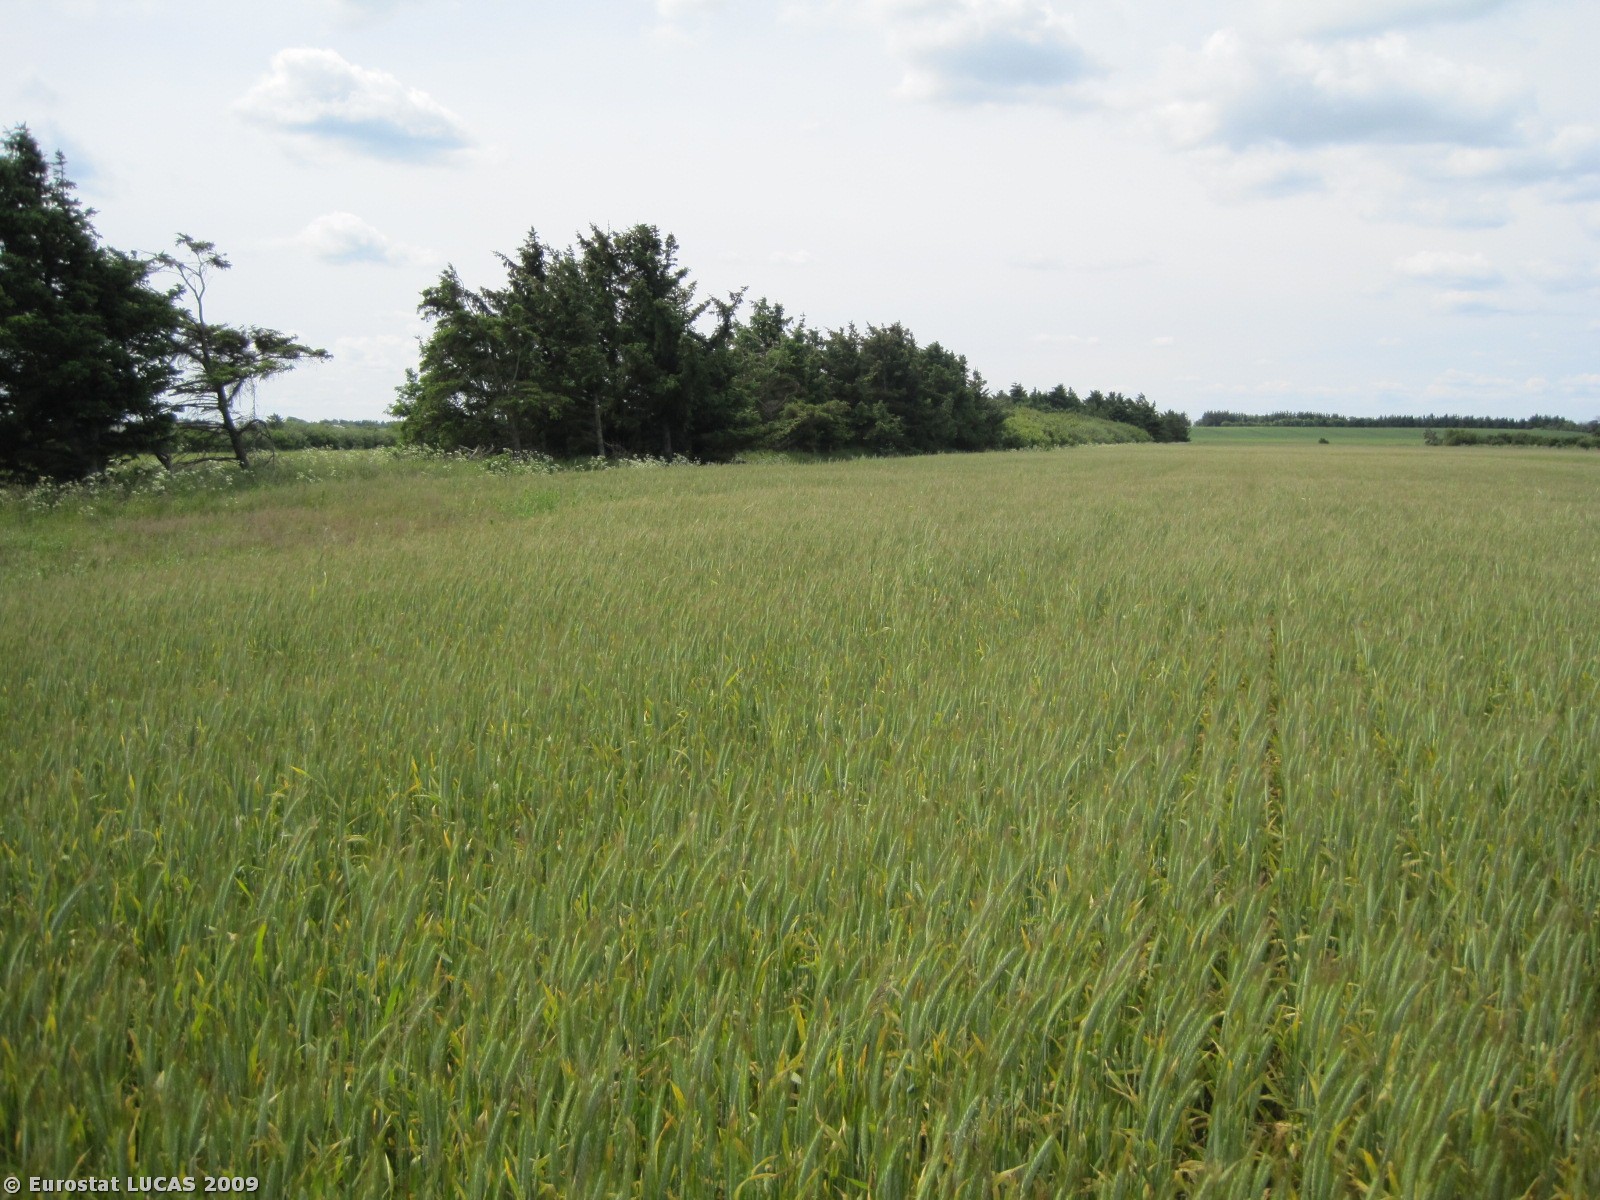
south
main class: Cropland
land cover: Barley
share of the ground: > 75 %
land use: Agriculture (excluding fallow land and kitchen gardens)
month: June
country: DK
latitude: 57.3740
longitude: 9.7510
